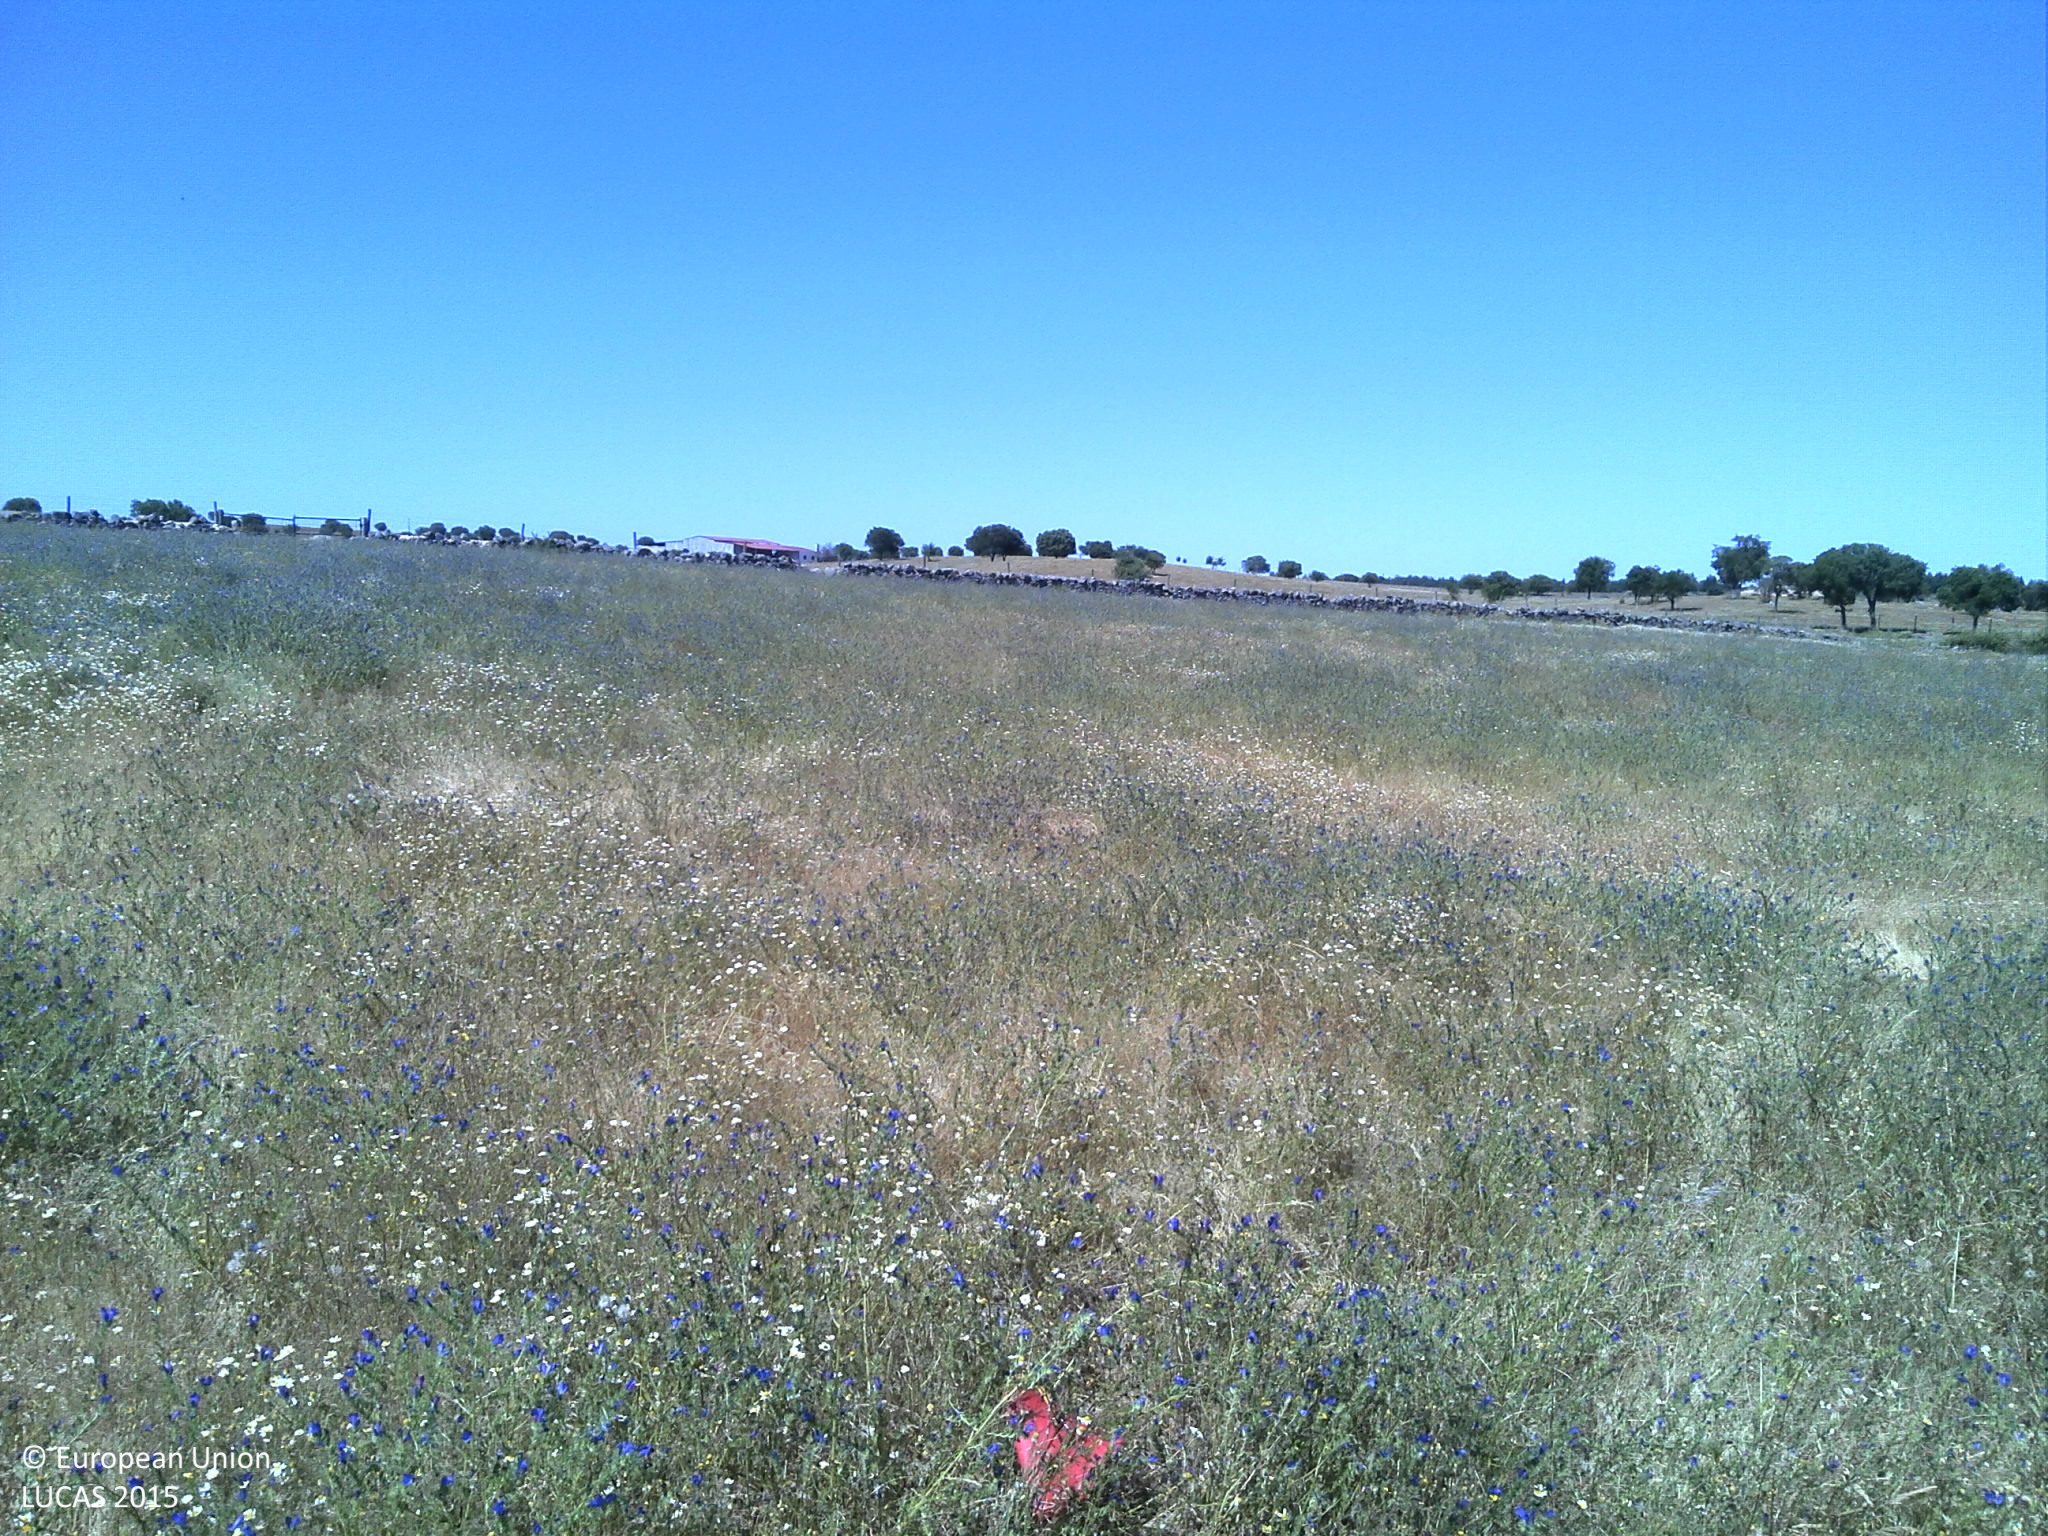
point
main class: Grassland
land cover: Grassland without tree/shrub cover
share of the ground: > 75 %
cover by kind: herbaceous plants 90 %, unconsolidated bare surface 10 %
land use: Agriculture (excluding fallow land and kitchen gardens)
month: May
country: PT
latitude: 39.3985
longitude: -7.7121
